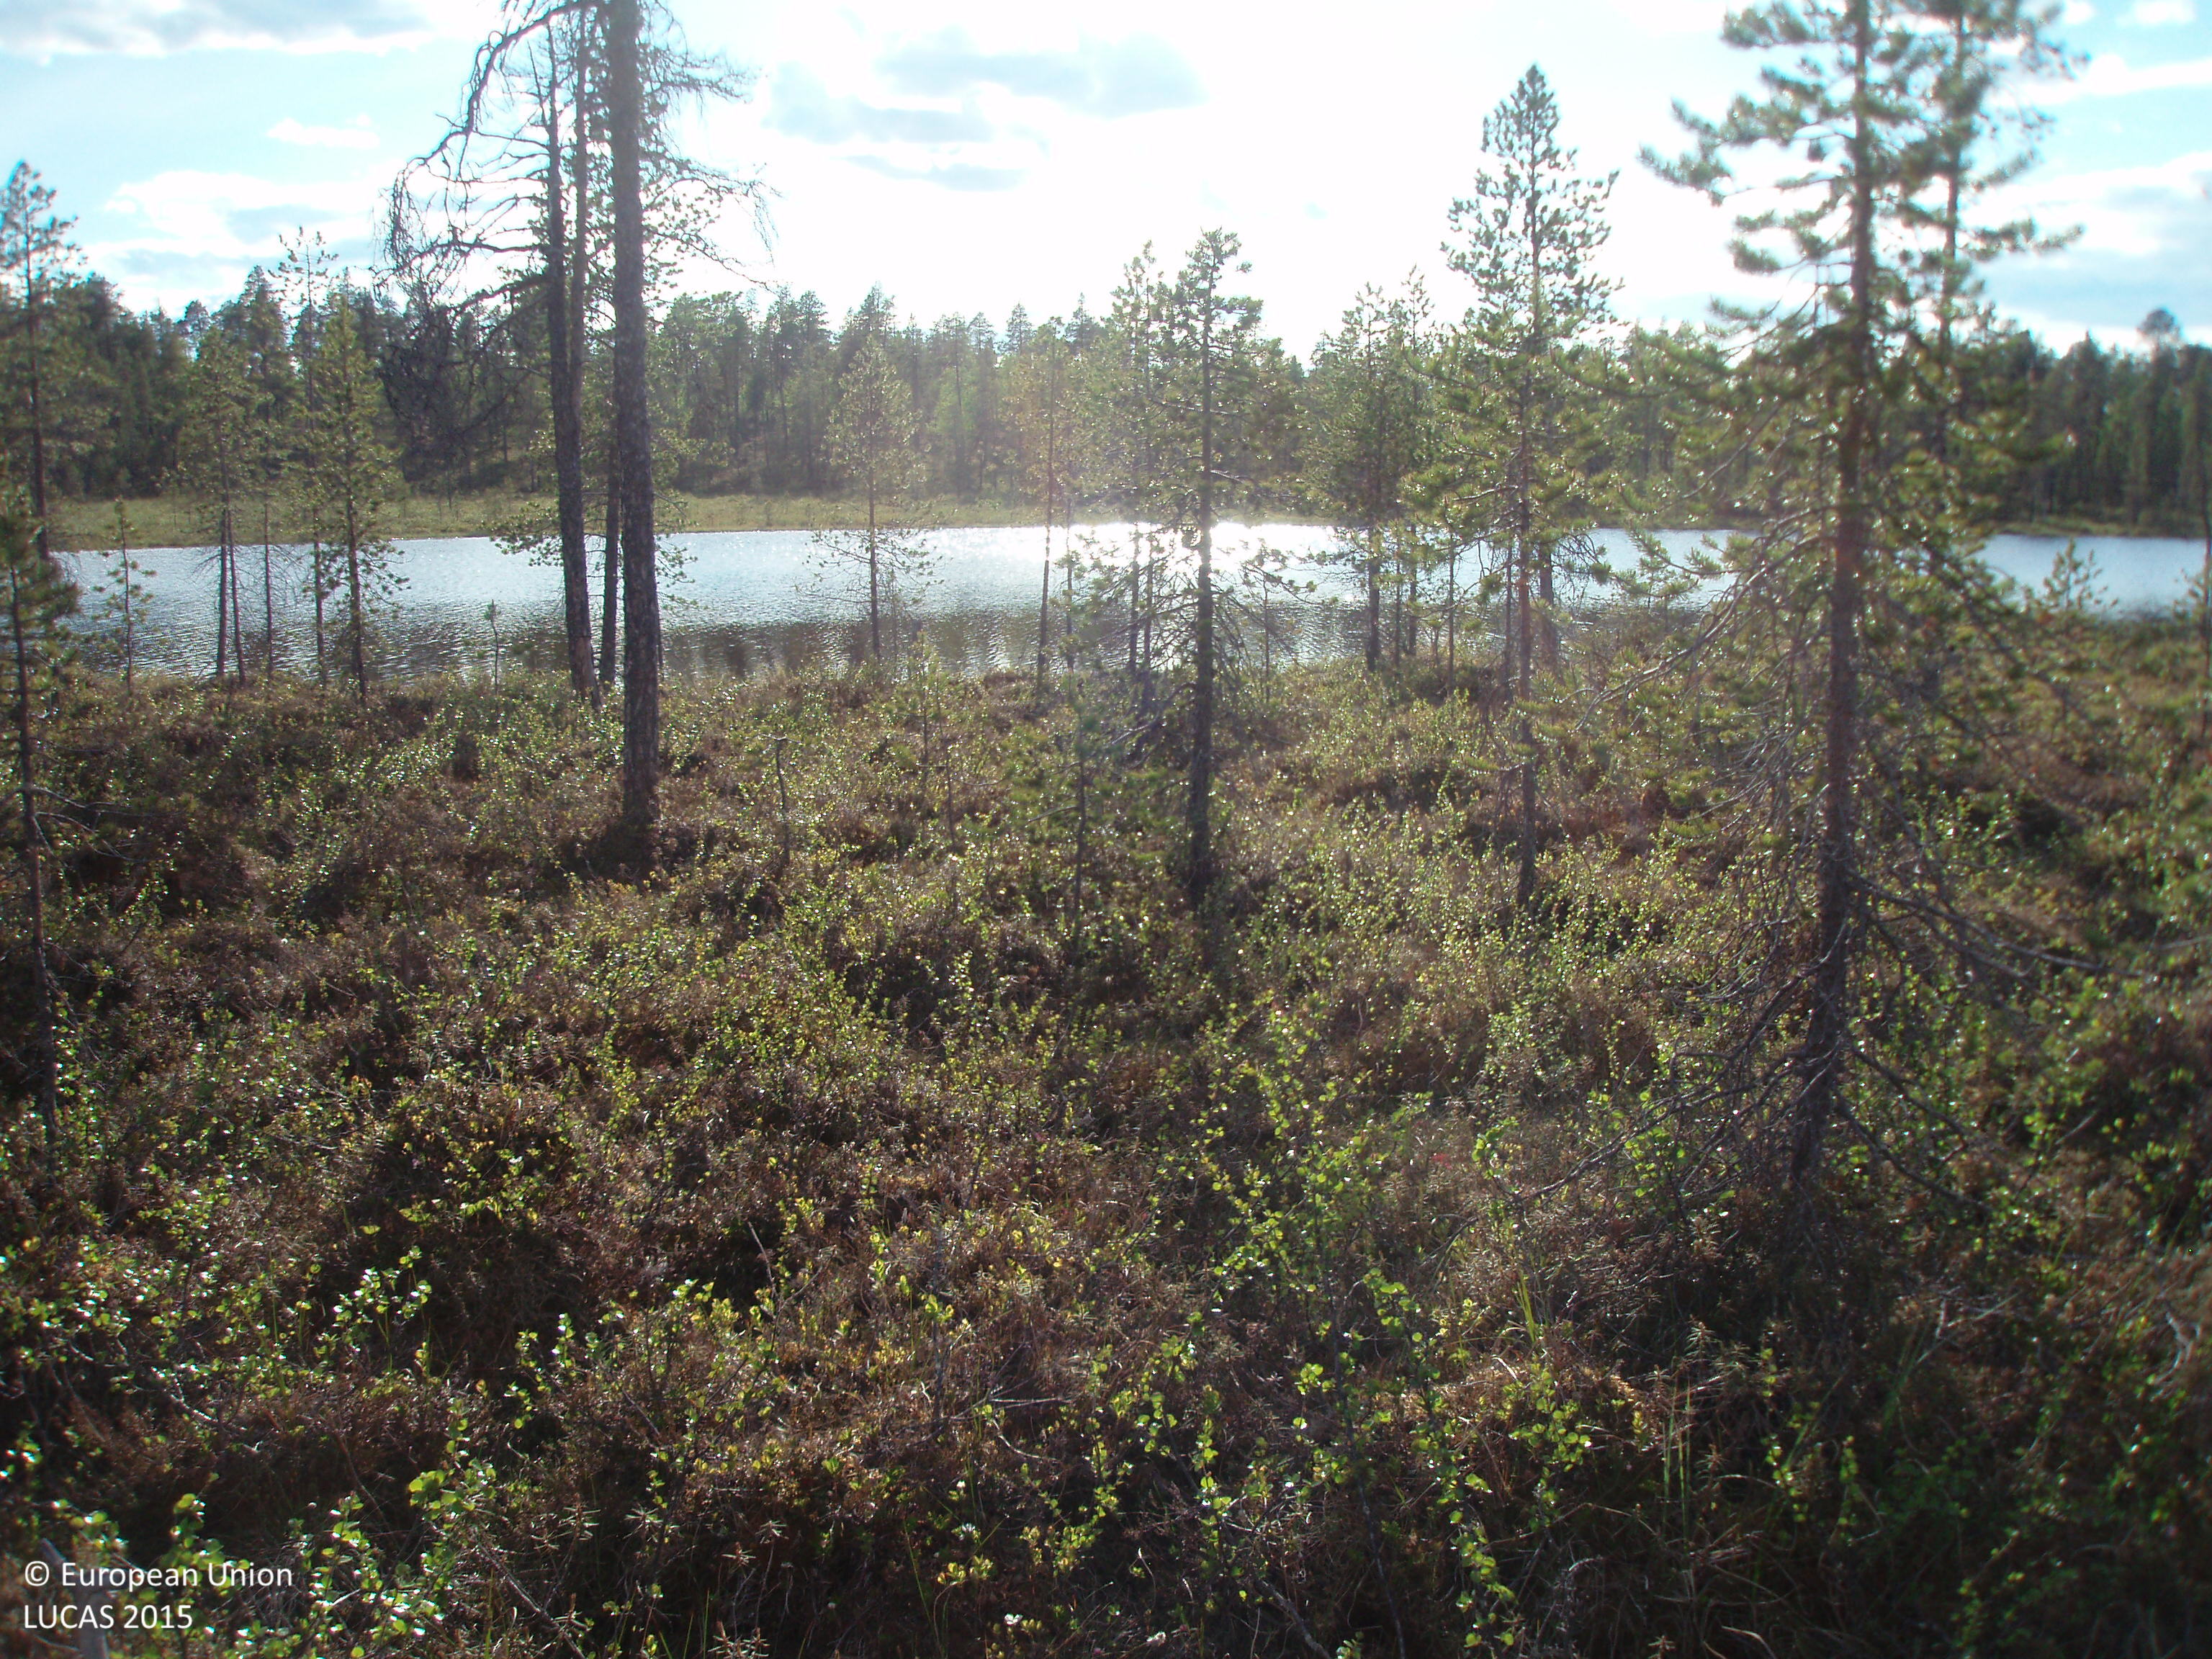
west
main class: Woodland
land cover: Pine dominated coniferous woodland
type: boreal forest
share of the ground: 25 - 50 %
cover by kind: shrubs 60 %, coniferous forest trees 30 %, lichens and mosses 10 %
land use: Semi-natural and natural areas not in use
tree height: > 5 m
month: June
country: FI
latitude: 68.7625
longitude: 28.5350
